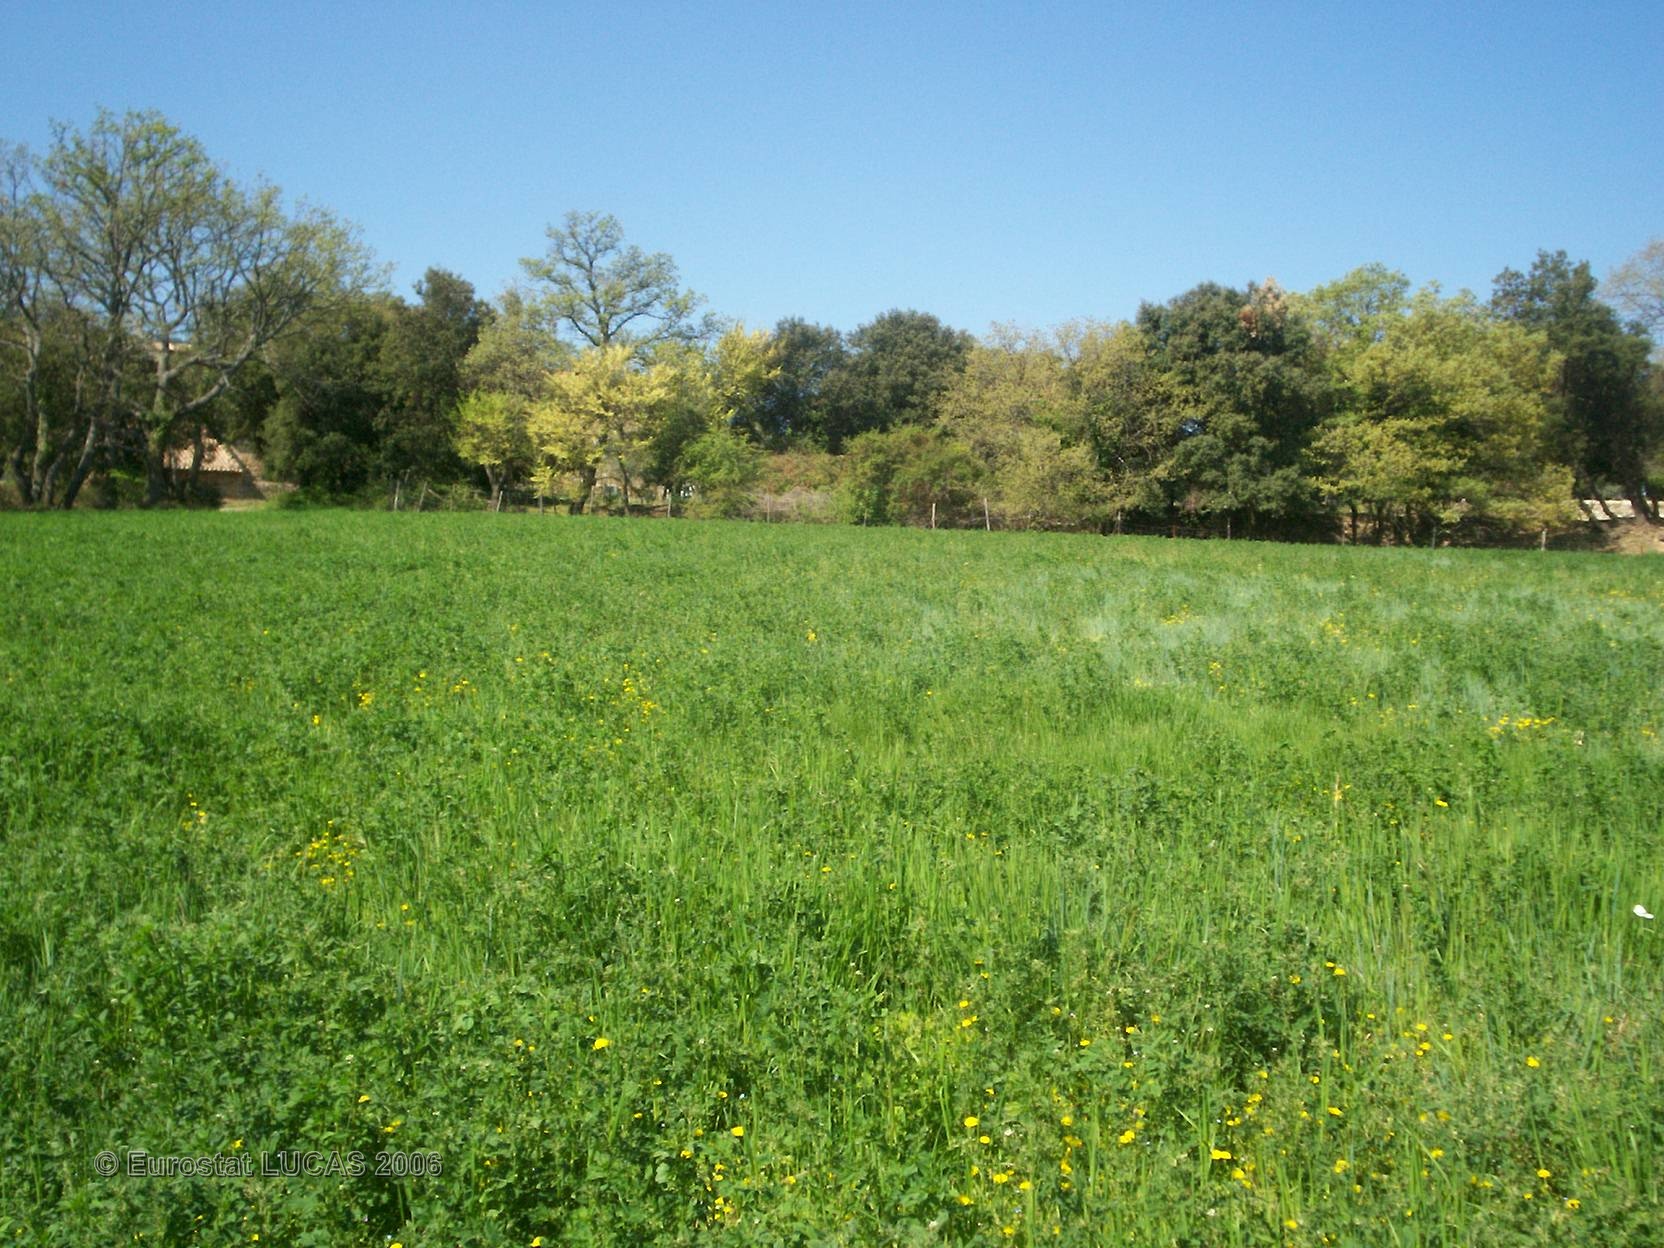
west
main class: Cropland
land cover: Lucerne
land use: Agriculture (excluding fallow land and kitchen gardens)
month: April
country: FR
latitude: 43.6084
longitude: 5.6357
